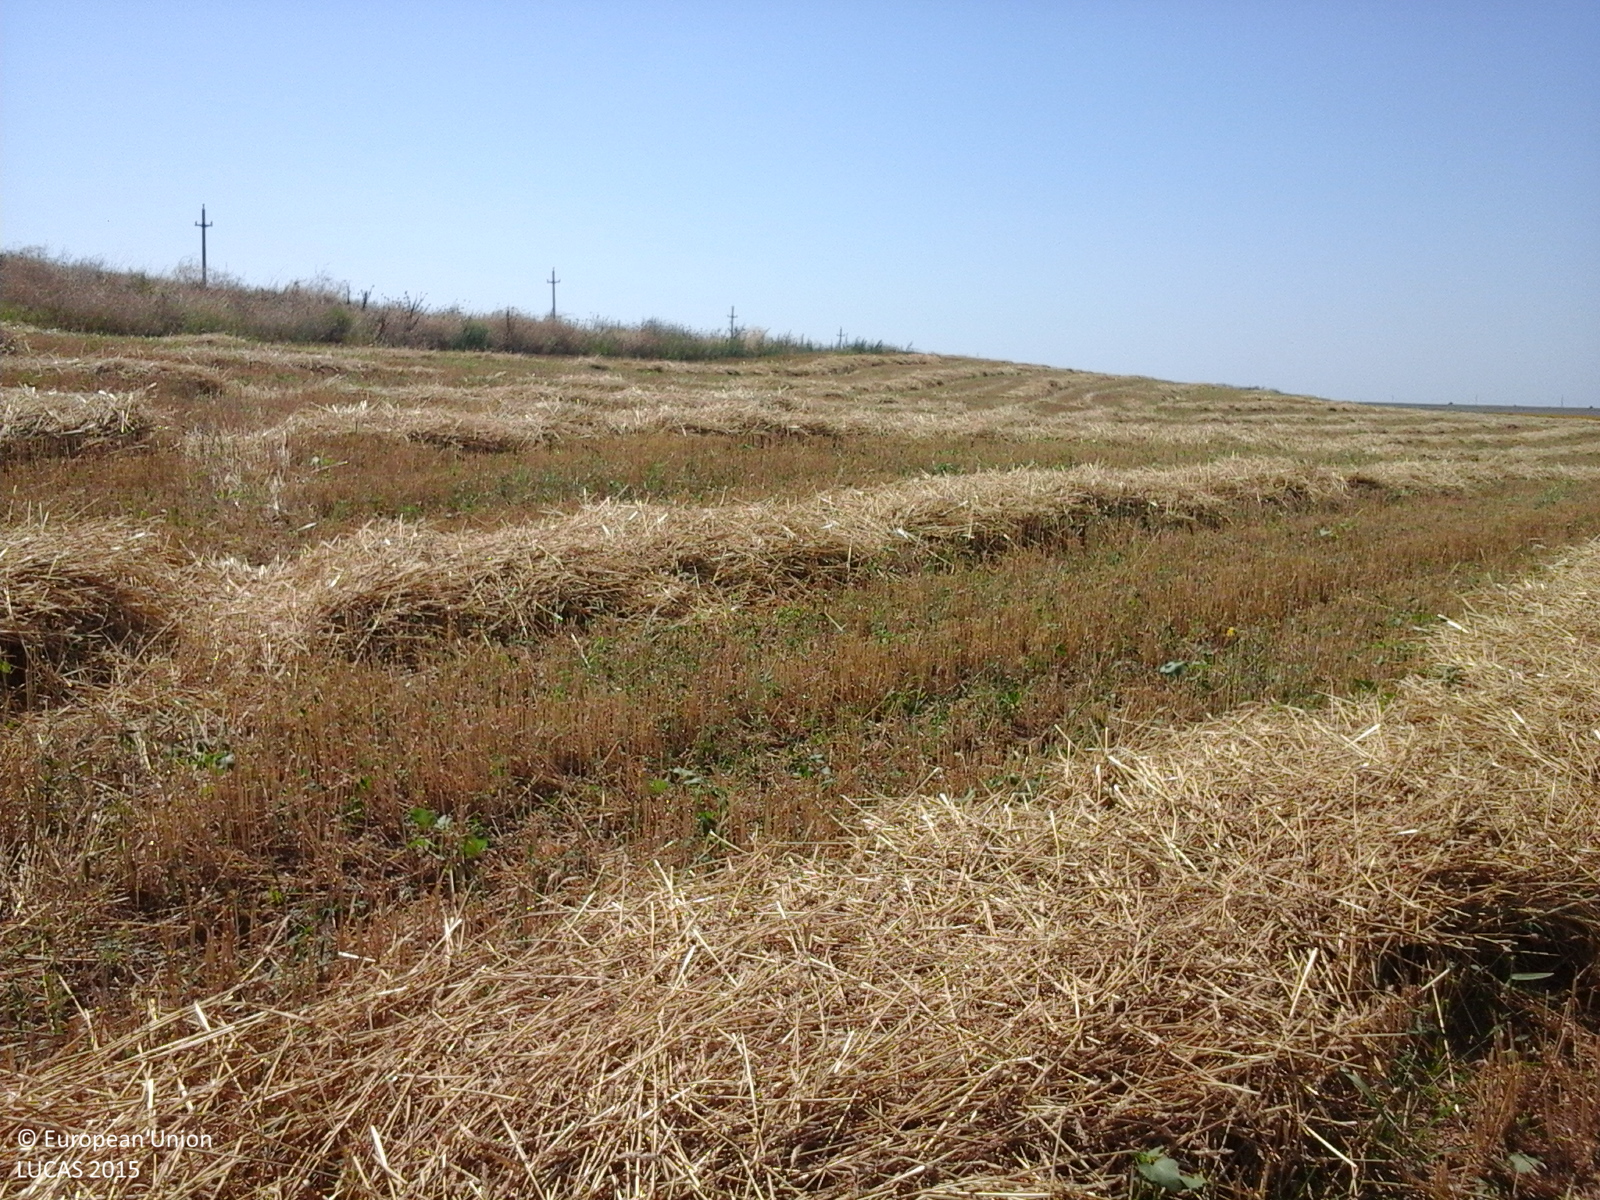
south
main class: Cropland
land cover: Common wheat
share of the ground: 50 - 75 %
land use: Agriculture (excluding fallow land and kitchen gardens)
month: August
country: RO
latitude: 44.6812
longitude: 28.0903
